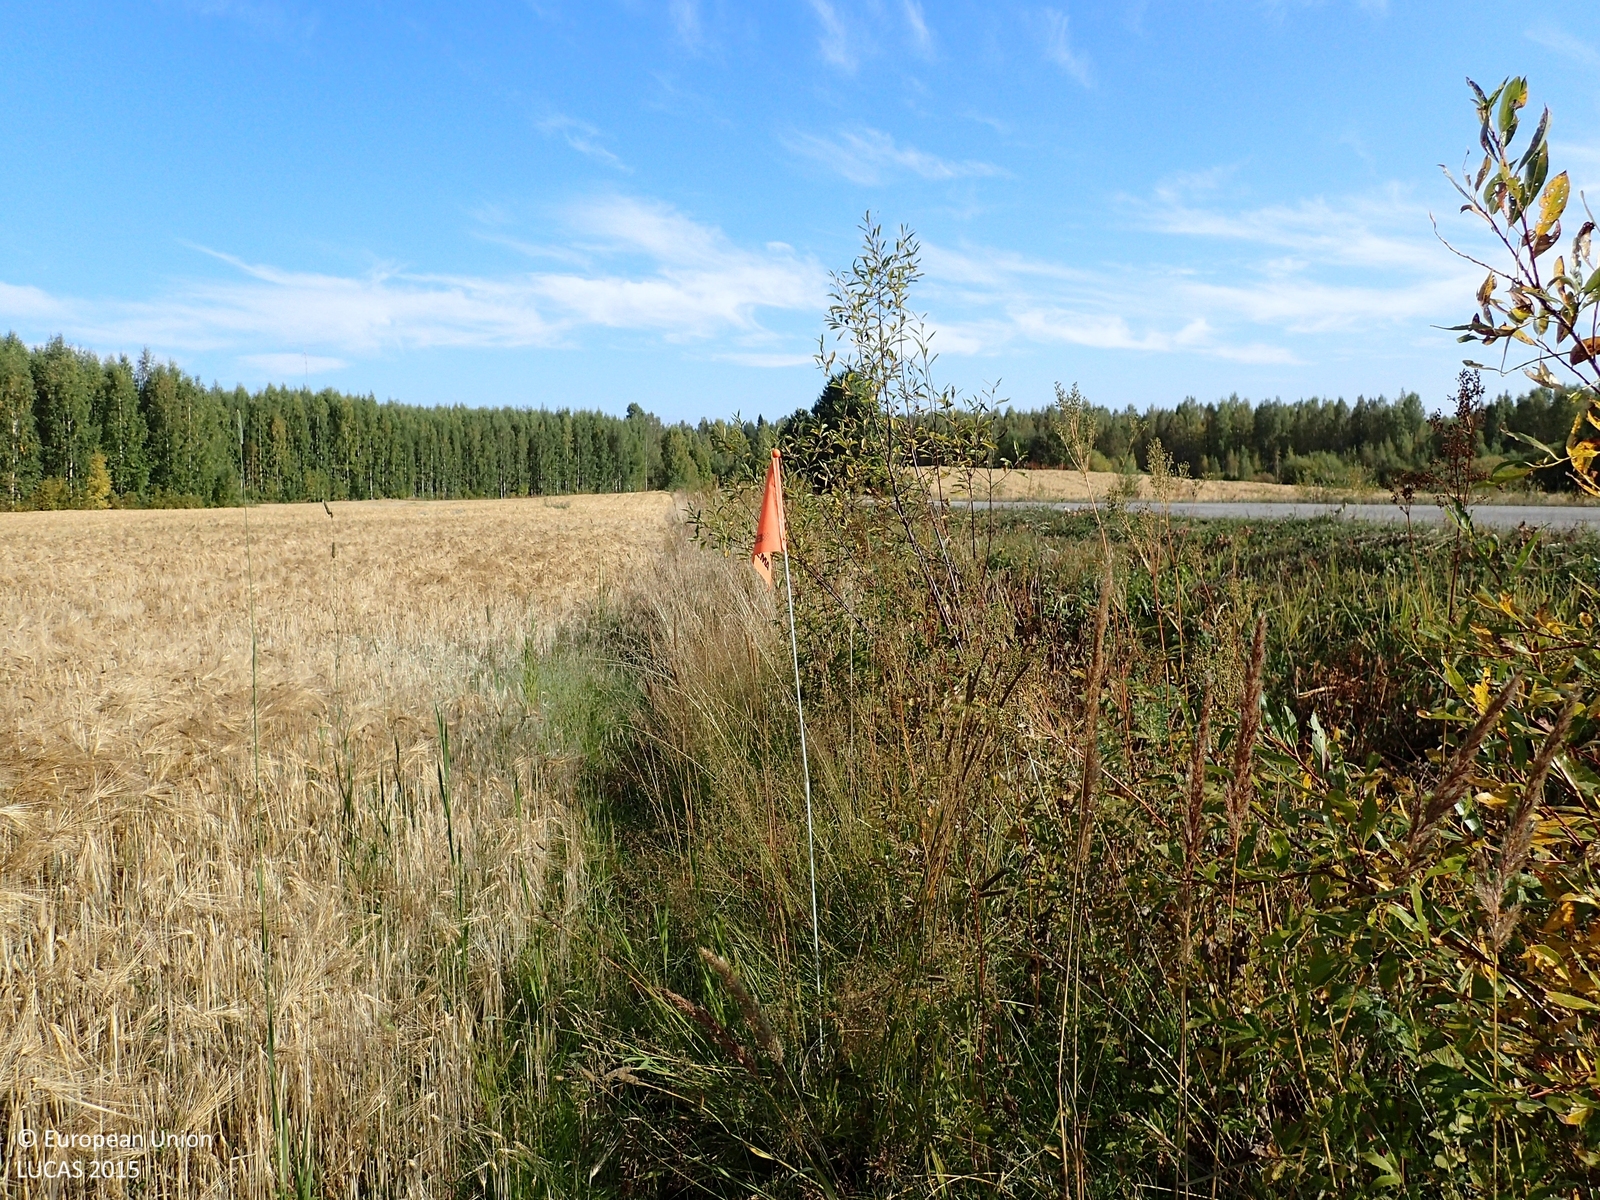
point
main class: Cropland
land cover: Barley
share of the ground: > 75 %
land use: Agriculture (excluding fallow land and kitchen gardens)
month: September
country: FI
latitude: 62.9775
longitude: 25.5557
